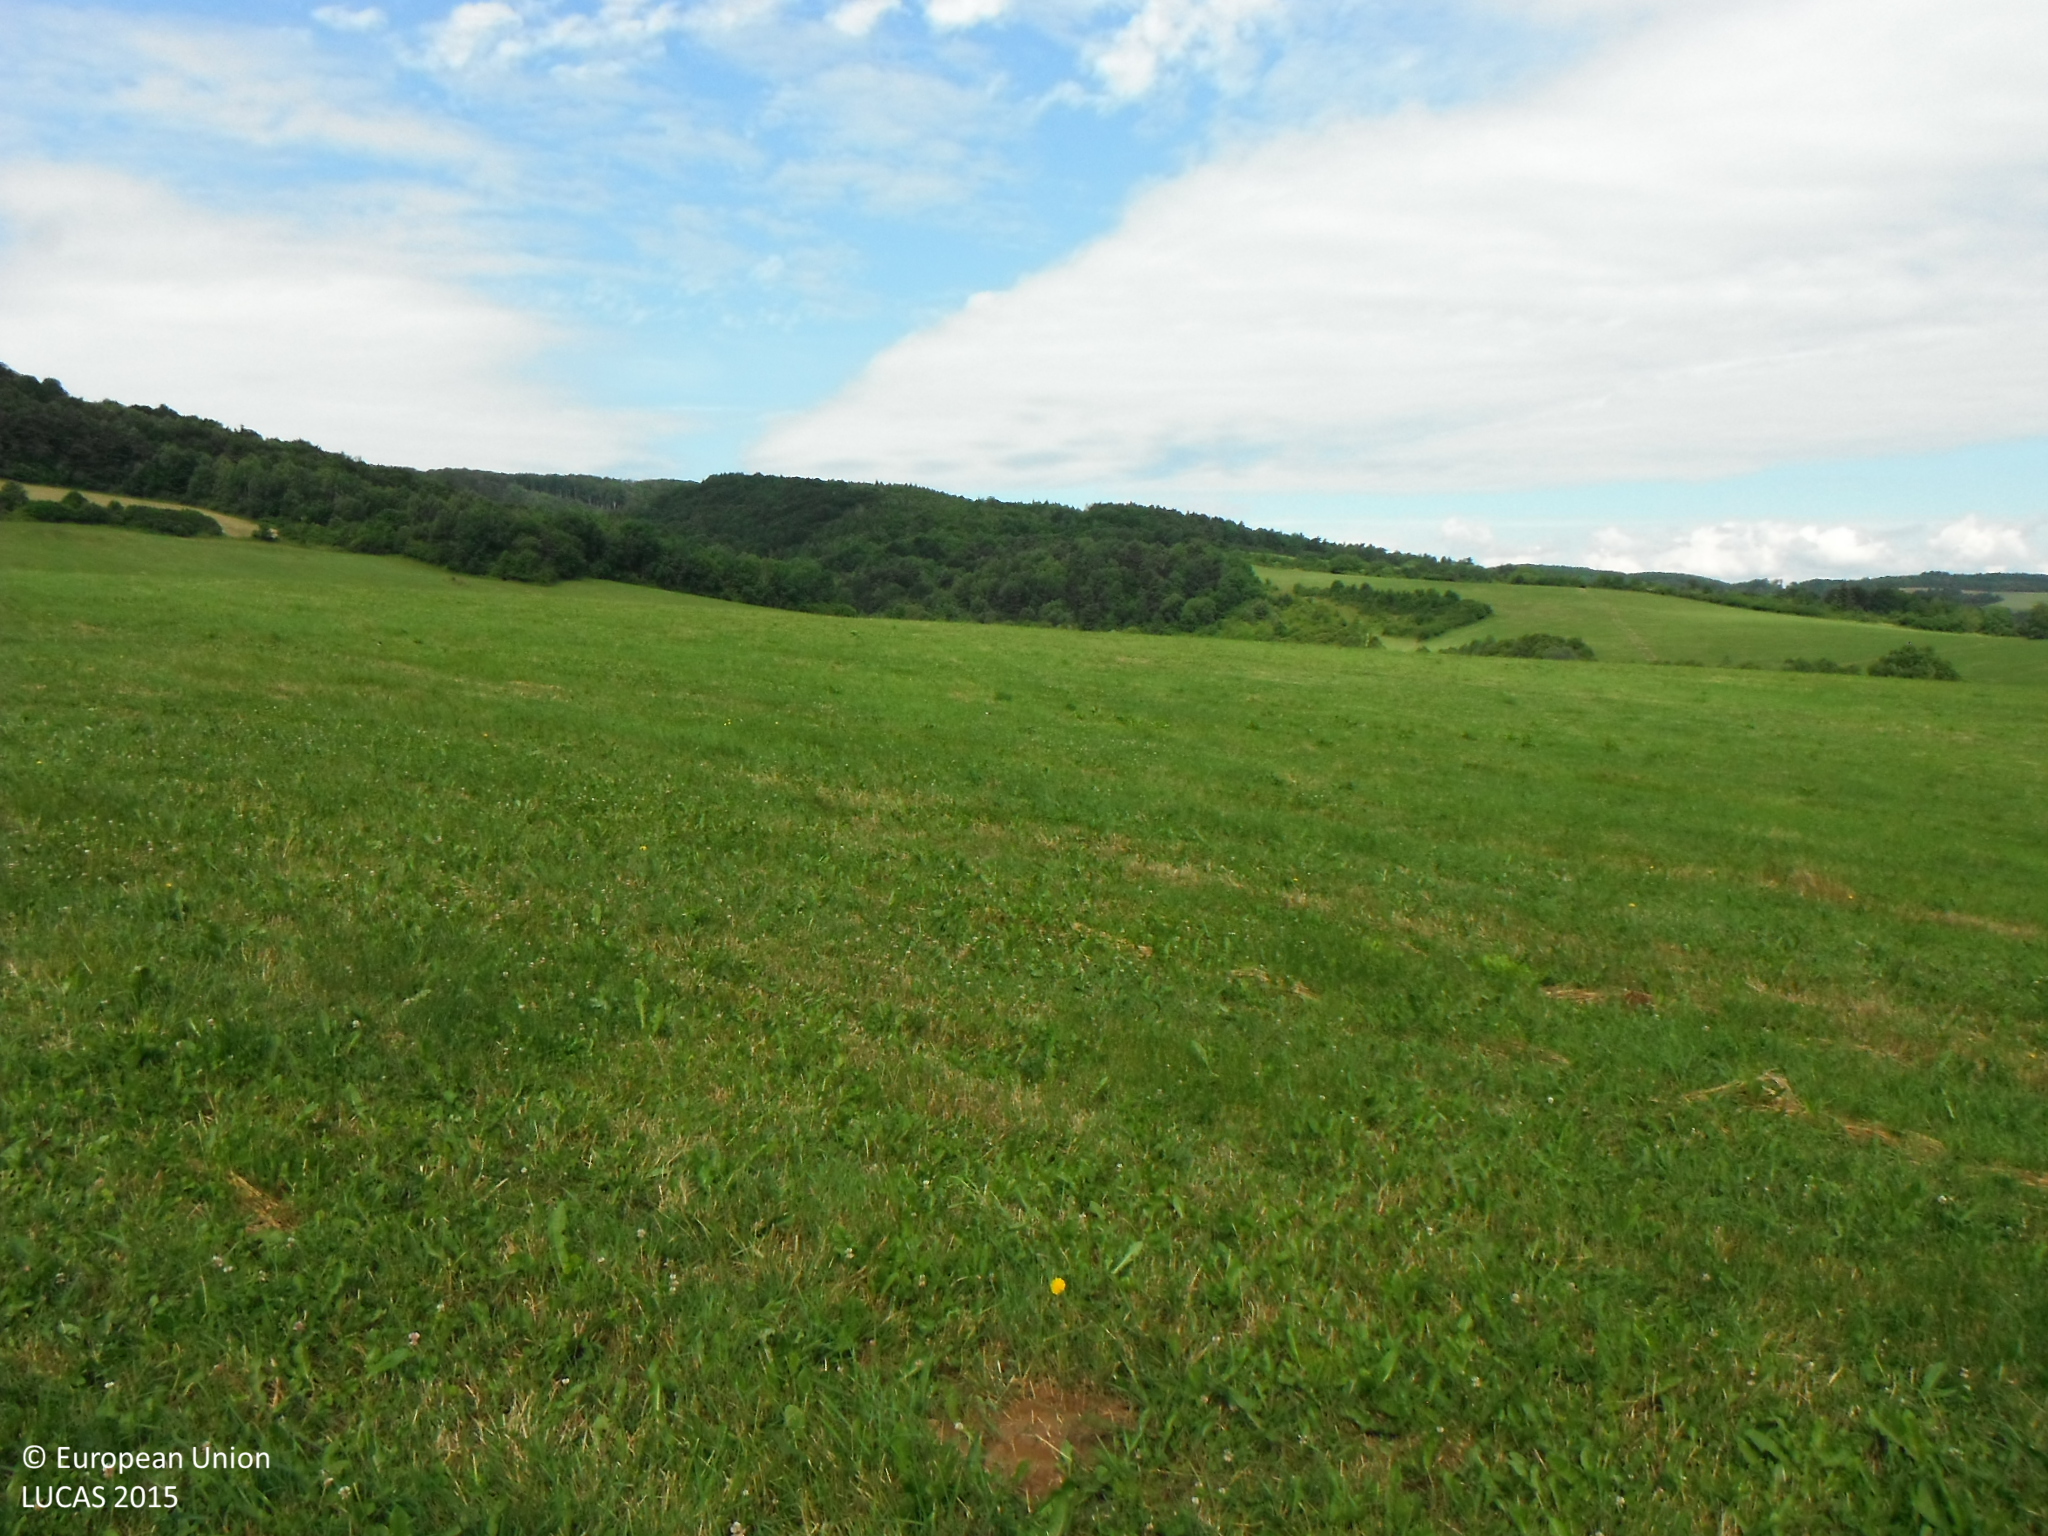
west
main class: Grassland
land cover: Grassland without tree/shrub cover
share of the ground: > 75 %
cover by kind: herbaceous plants 100 %
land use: Agriculture (excluding fallow land and kitchen gardens)
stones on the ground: < 10 %
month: June
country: SK
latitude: 49.1528
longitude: 21.6086
